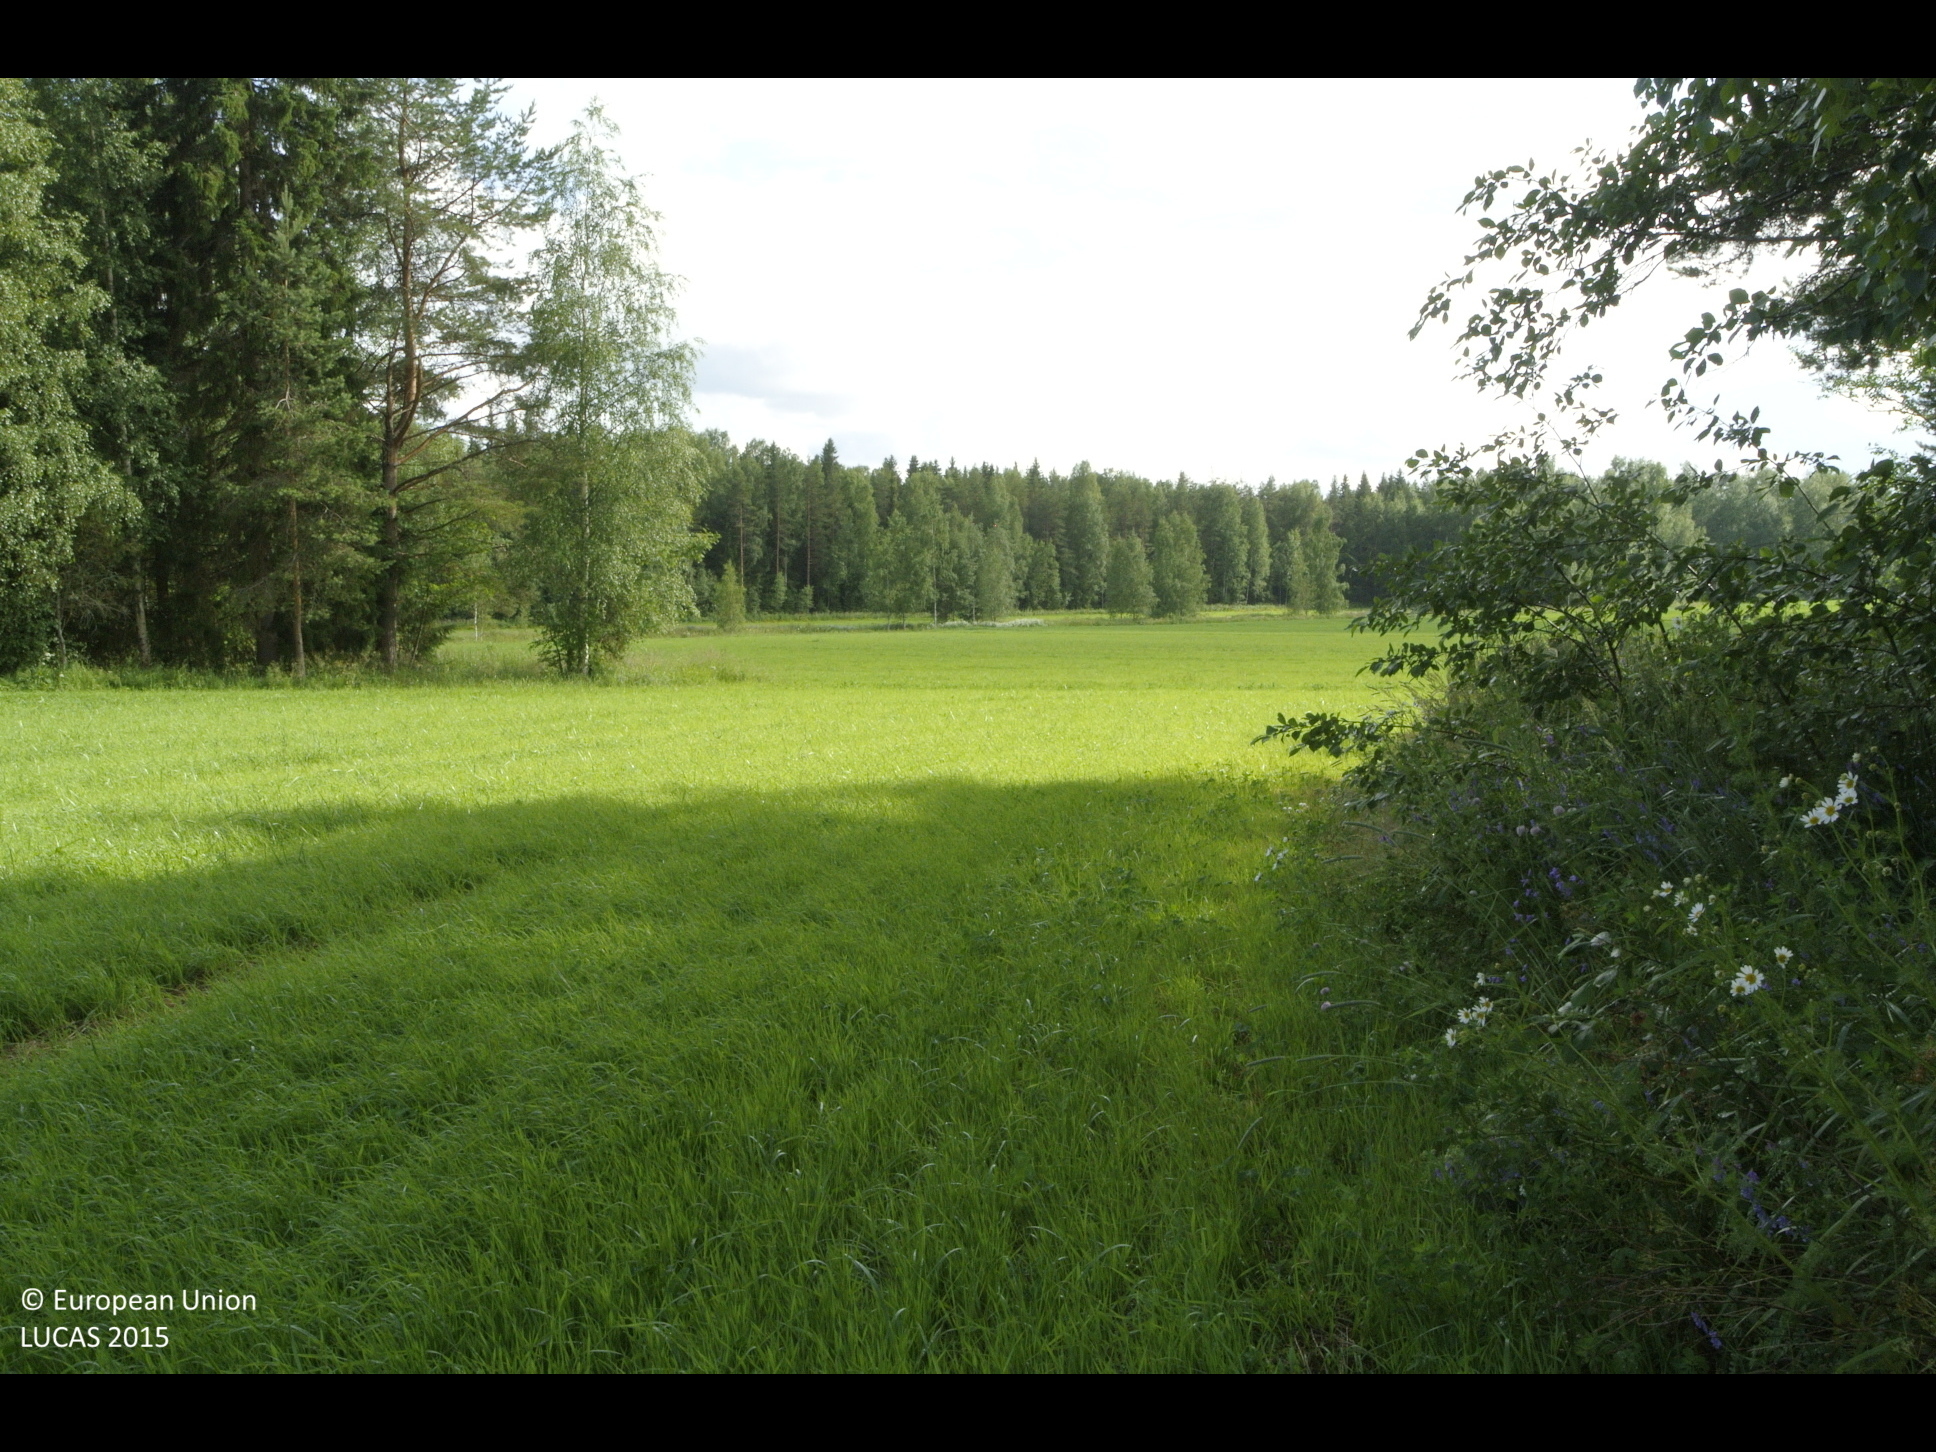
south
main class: Cropland
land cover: Other leguminous and mixtures for fodder
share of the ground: > 75 %
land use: Agriculture (excluding fallow land and kitchen gardens)
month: July
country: FI
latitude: 61.3910
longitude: 25.7224
